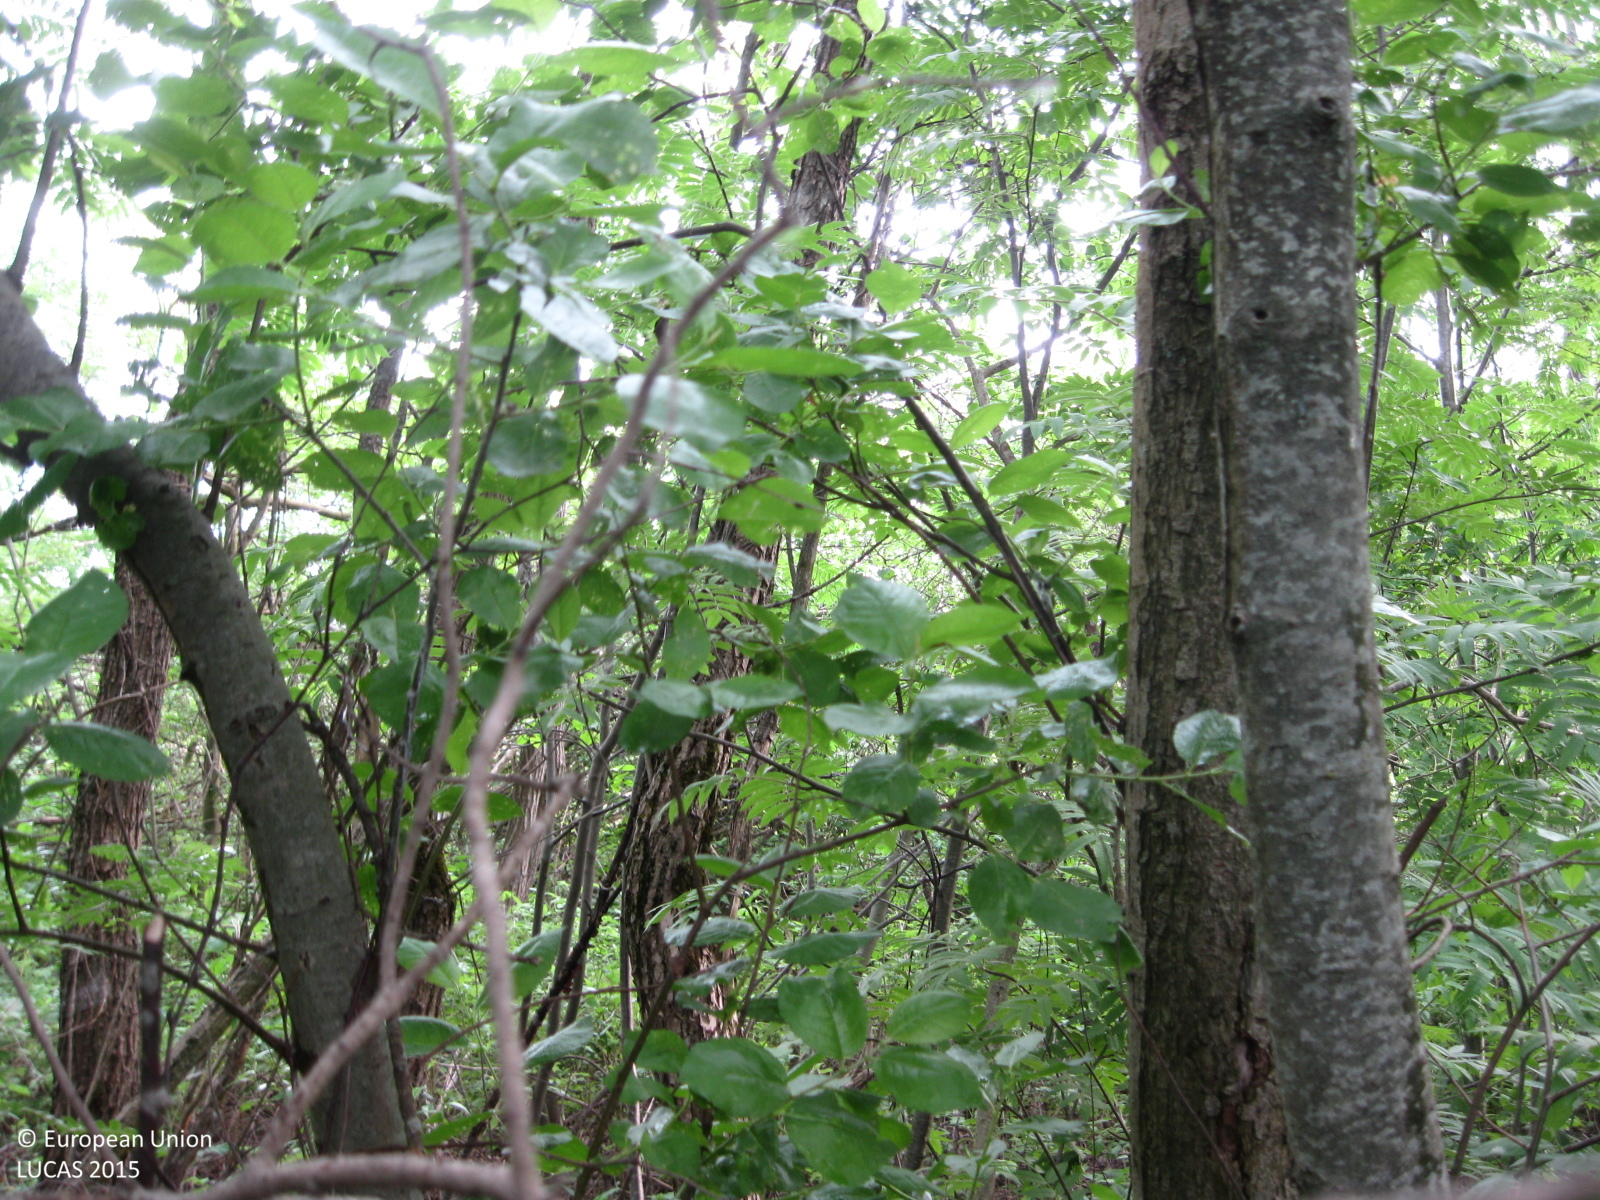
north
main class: Woodland
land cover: Broadleaved woodland
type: non-riverine alder, birch or aspen forest
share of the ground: > 75 %
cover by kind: broadleaved forest trees 75 %, shrubs 10 %, herbaceous plants 10 %, coniferous forest trees 5 %
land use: Semi-natural and natural areas not in use
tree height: > 5 m
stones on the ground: < 10 %
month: June
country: LT
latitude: 55.7262
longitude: 23.6631
